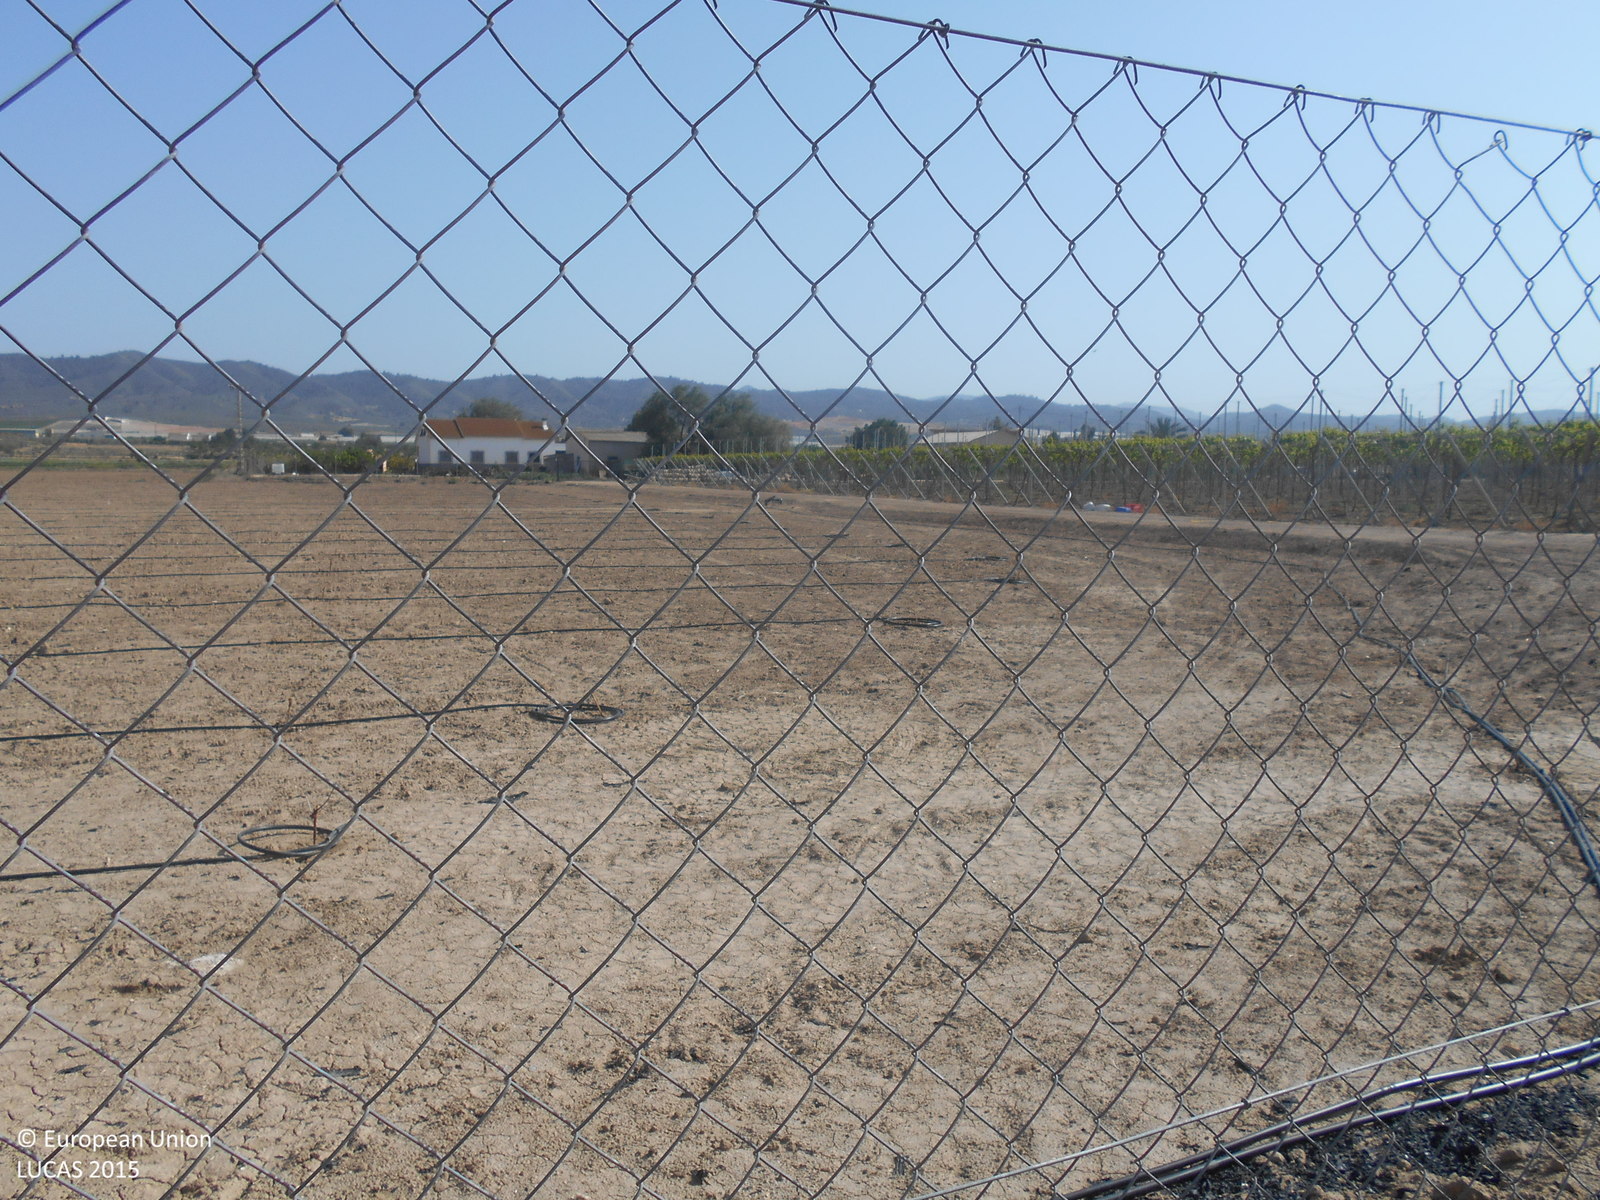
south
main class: Cropland
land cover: Vineyards
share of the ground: 25 - 50 %
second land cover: Other bare soil
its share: > 75 %
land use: Agriculture (excluding fallow land and kitchen gardens)
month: April
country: ES
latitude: 37.7041
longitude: -1.5174
